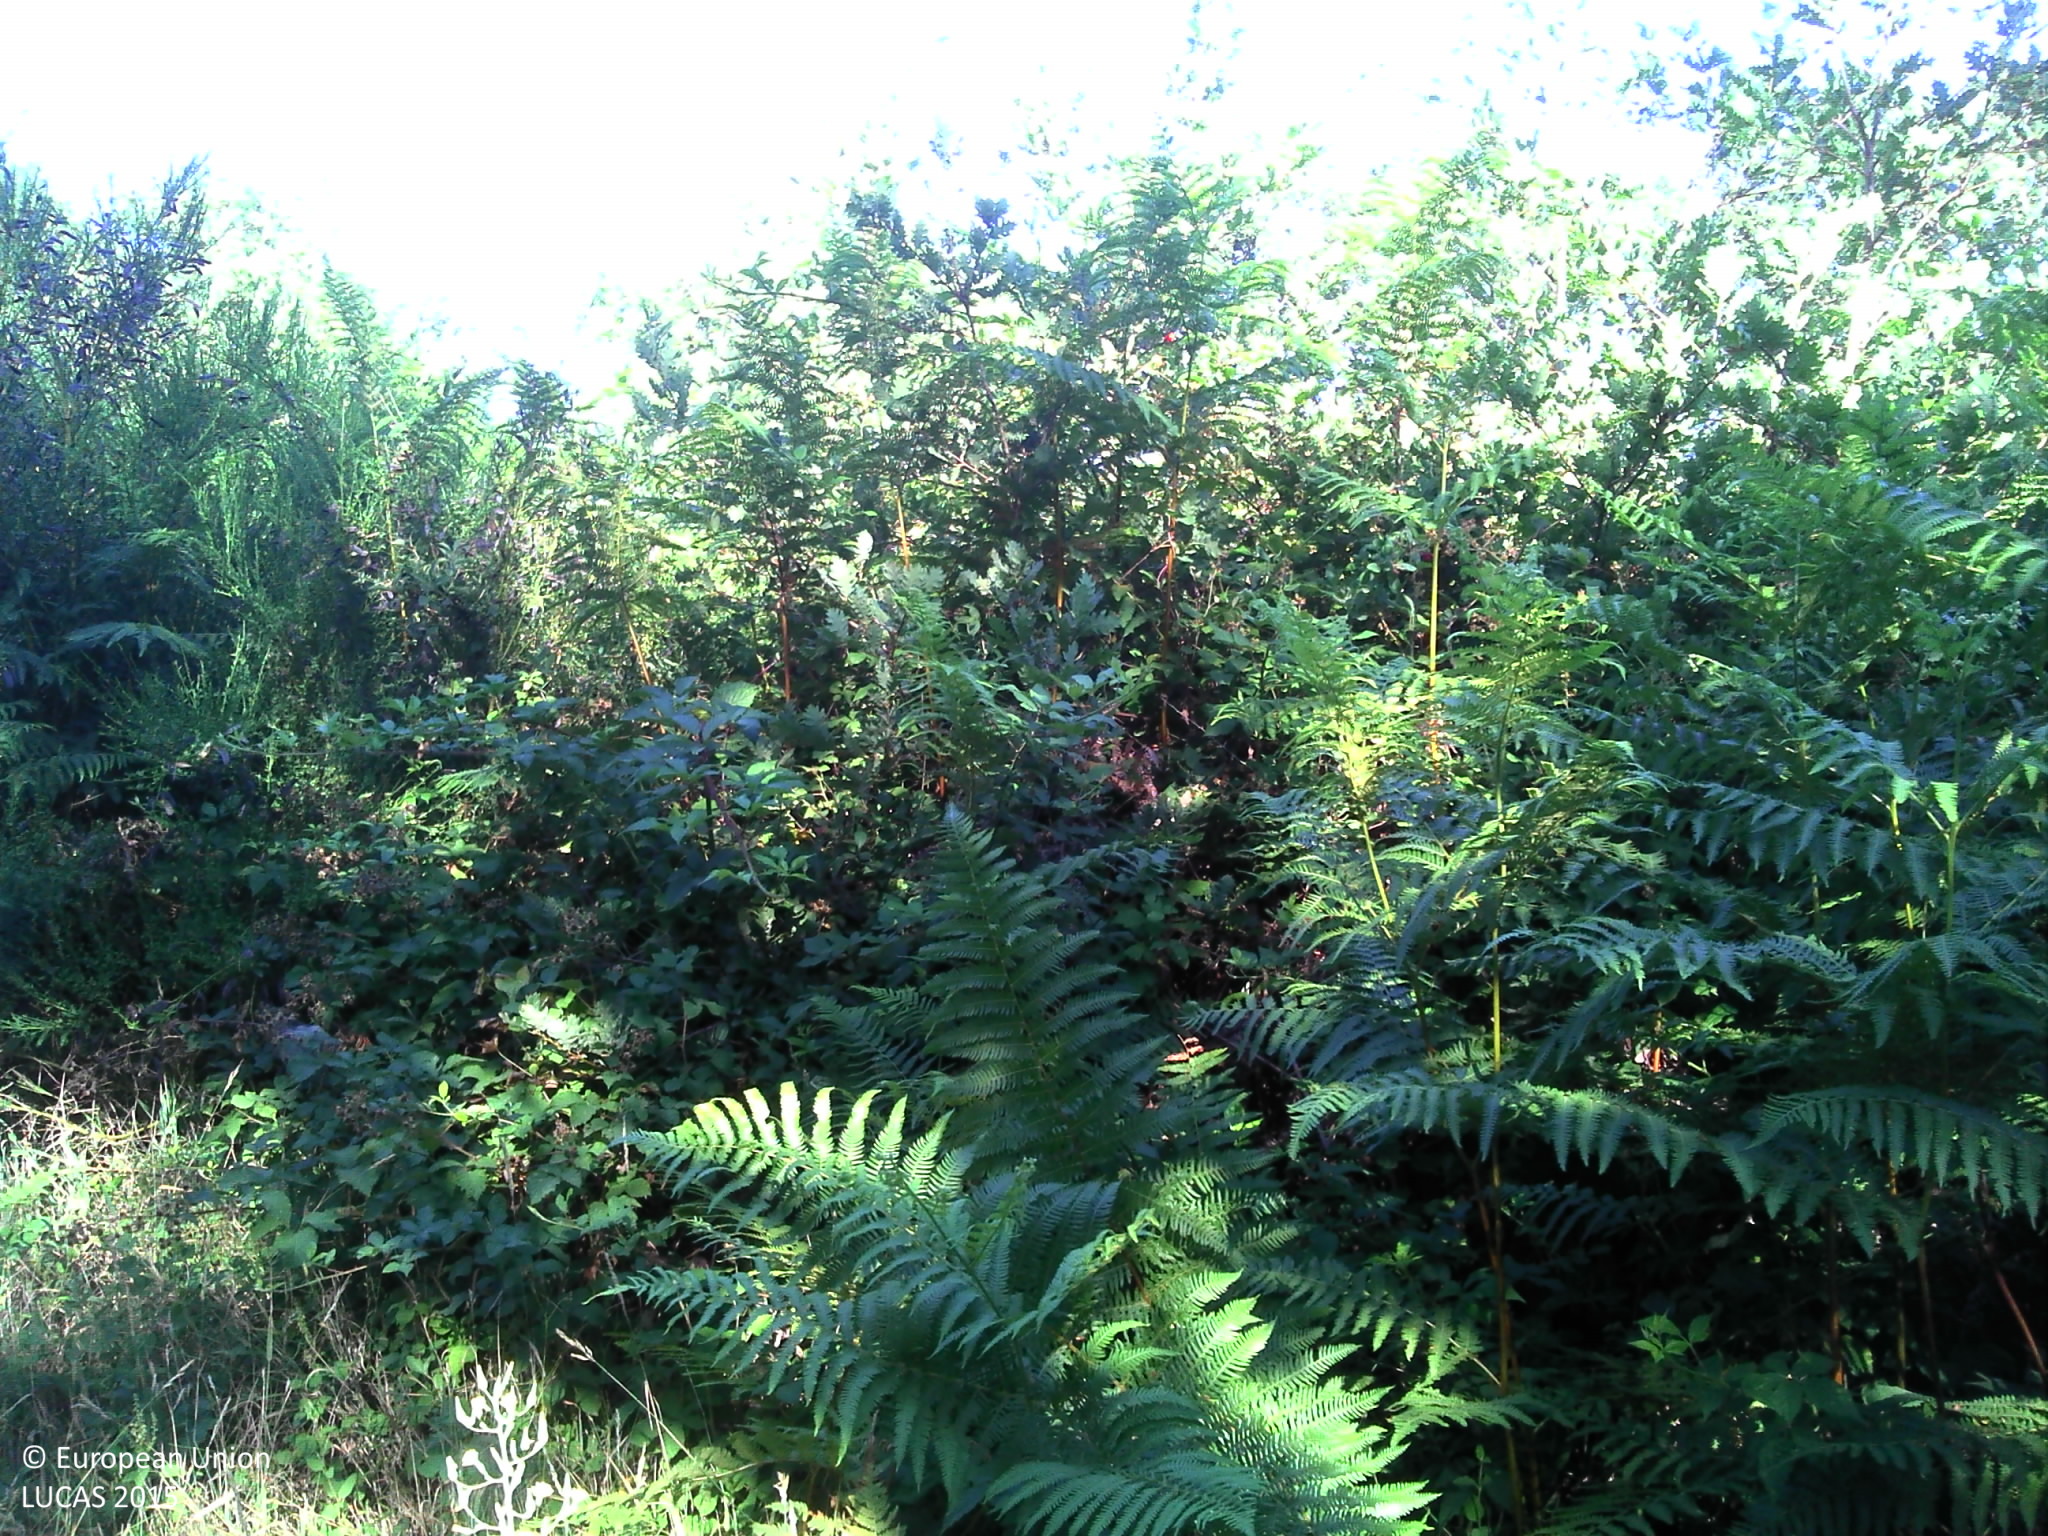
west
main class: Grassland
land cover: Spontaneously vegetated surfaces
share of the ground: > 75 %
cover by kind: herbaceous plants 60 %, lichens and mosses 15 %, shrubs 5 %
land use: Forestry
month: June
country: FR
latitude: 43.7711
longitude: 1.5669
